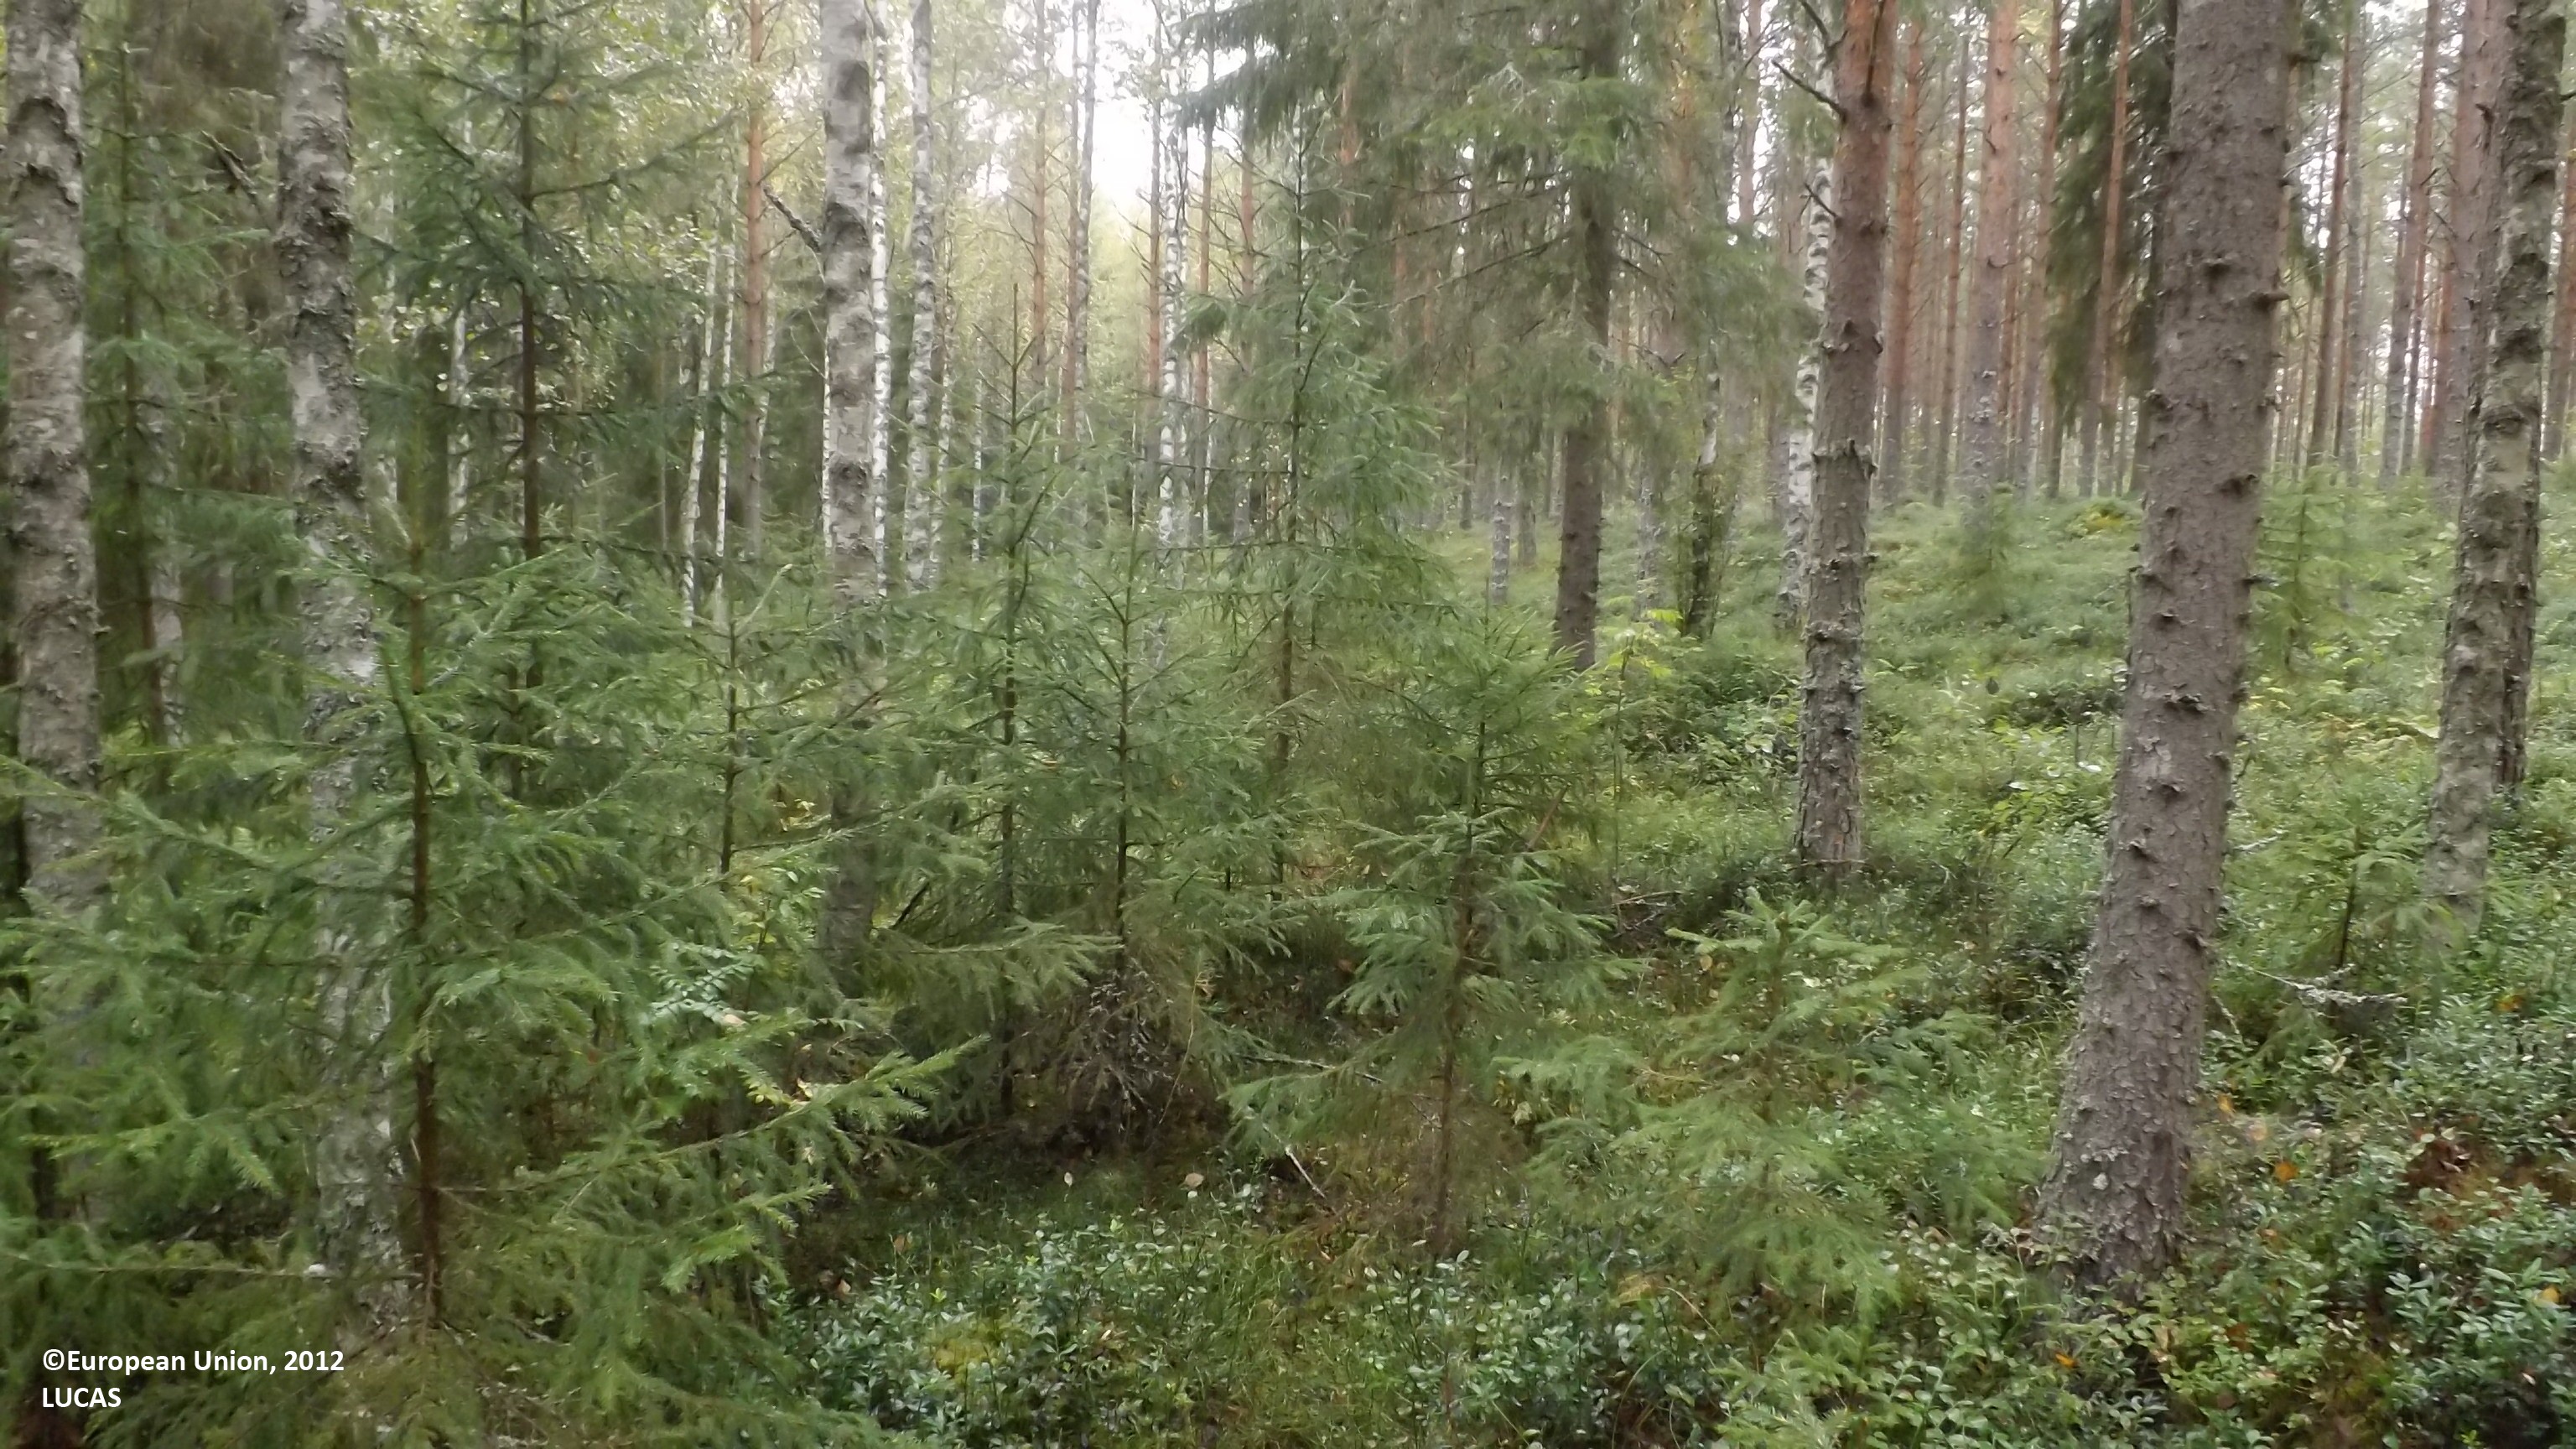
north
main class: Woodland
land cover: Other mixed woodland
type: boreal forest
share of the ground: 50 - 75 %
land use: Forestry
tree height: > 5 m
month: August
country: FI
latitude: 63.7770
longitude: 23.5492
